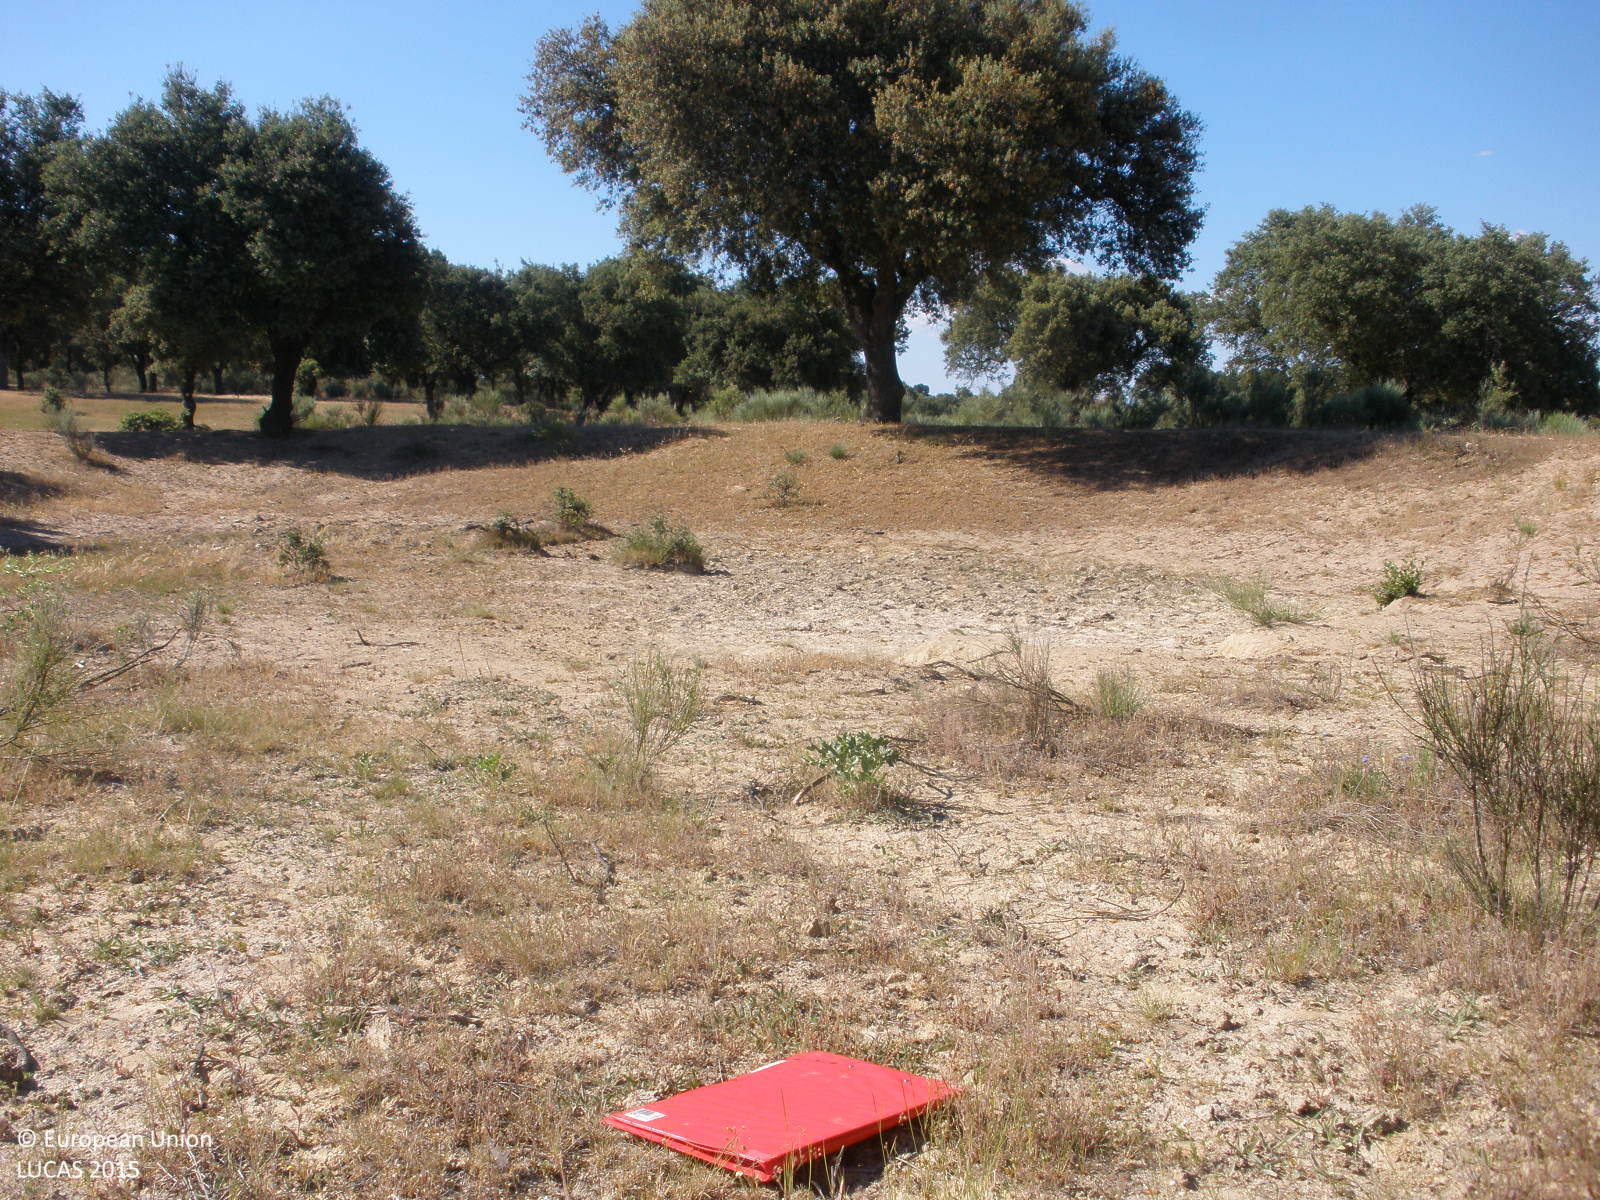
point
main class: Shrubland
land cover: Shrubland with sparse tree cover
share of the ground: 50 - 75 %
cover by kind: shrubs 50 %, herbaceous plants 35 %, consolidated bare surface 10 %, broadleaved forest trees 5 %
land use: Agriculture (excluding fallow land and kitchen gardens)
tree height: < 5 m
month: June
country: ES
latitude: 40.5021
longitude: -6.6947
